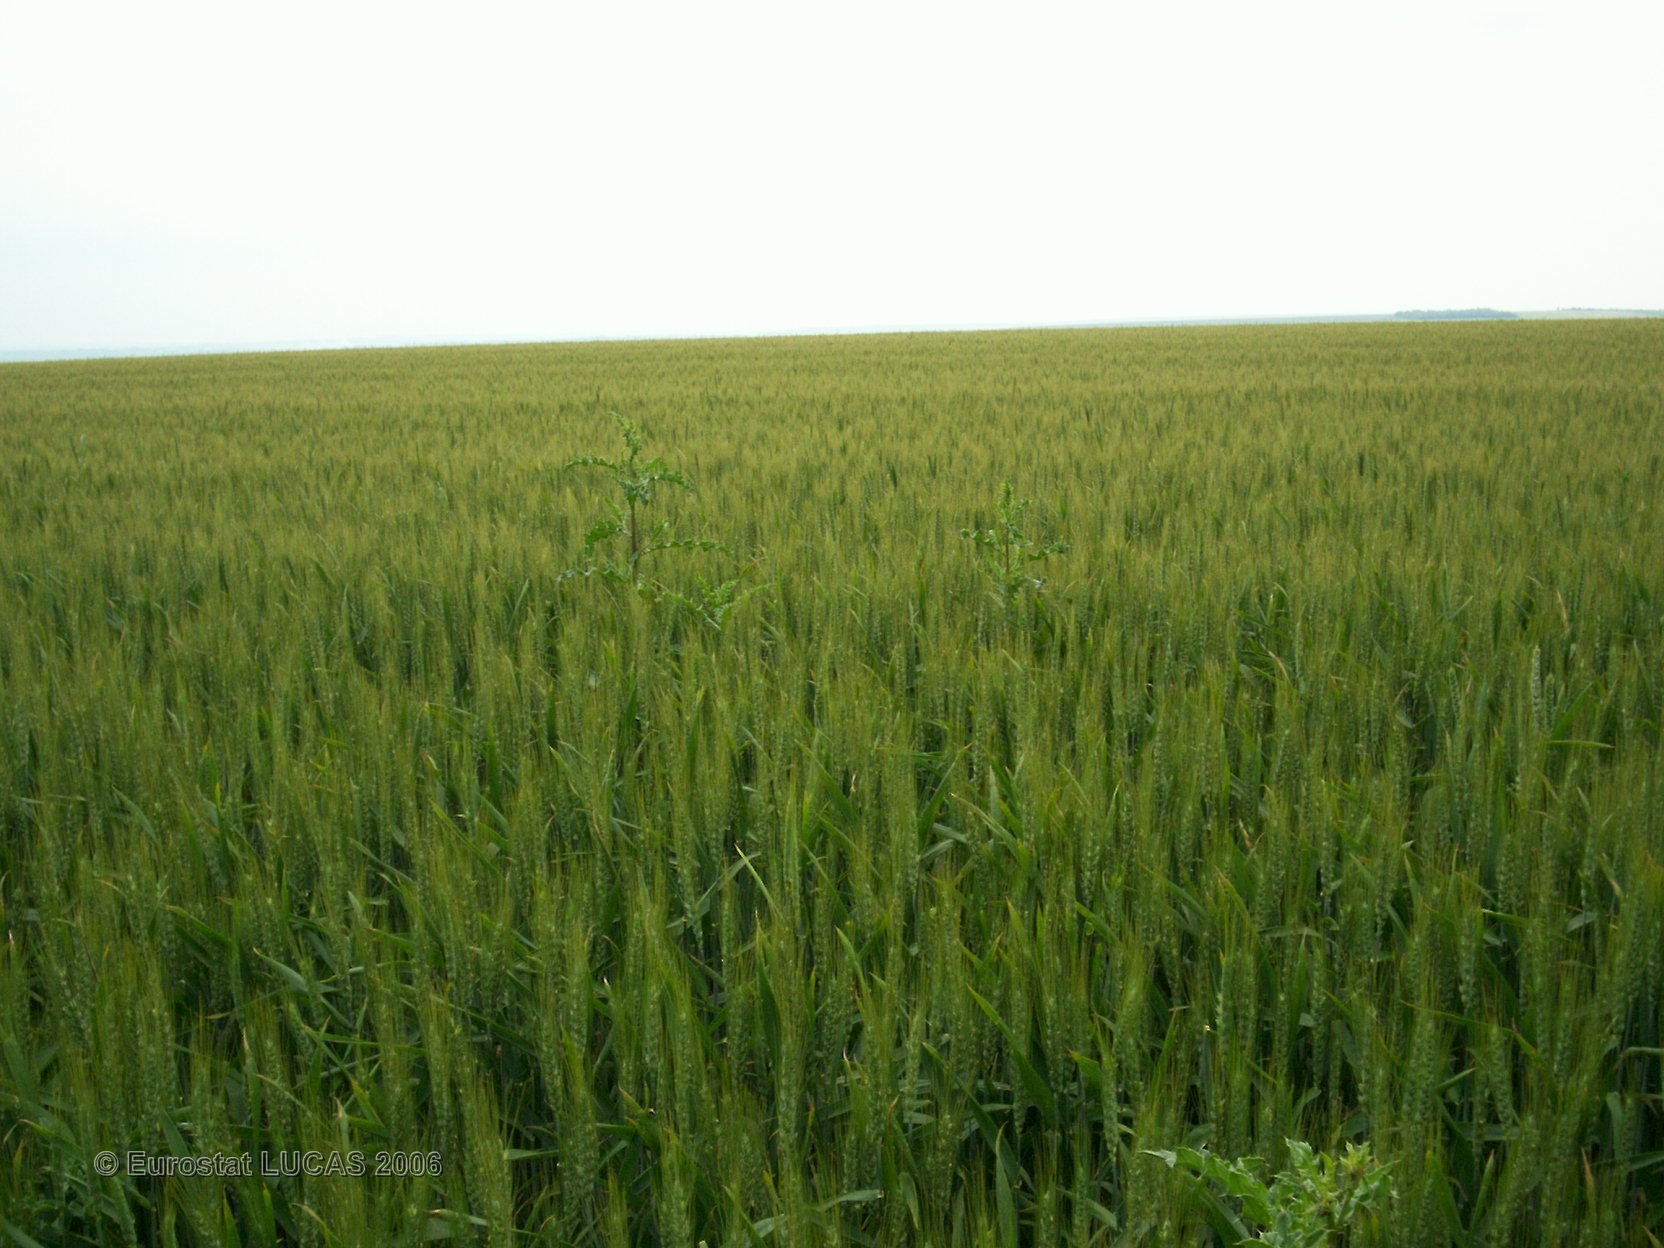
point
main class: Cropland
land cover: Barley
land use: Agriculture (excluding fallow land and kitchen gardens)
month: June
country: FR
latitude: 48.6992
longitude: 4.4942
